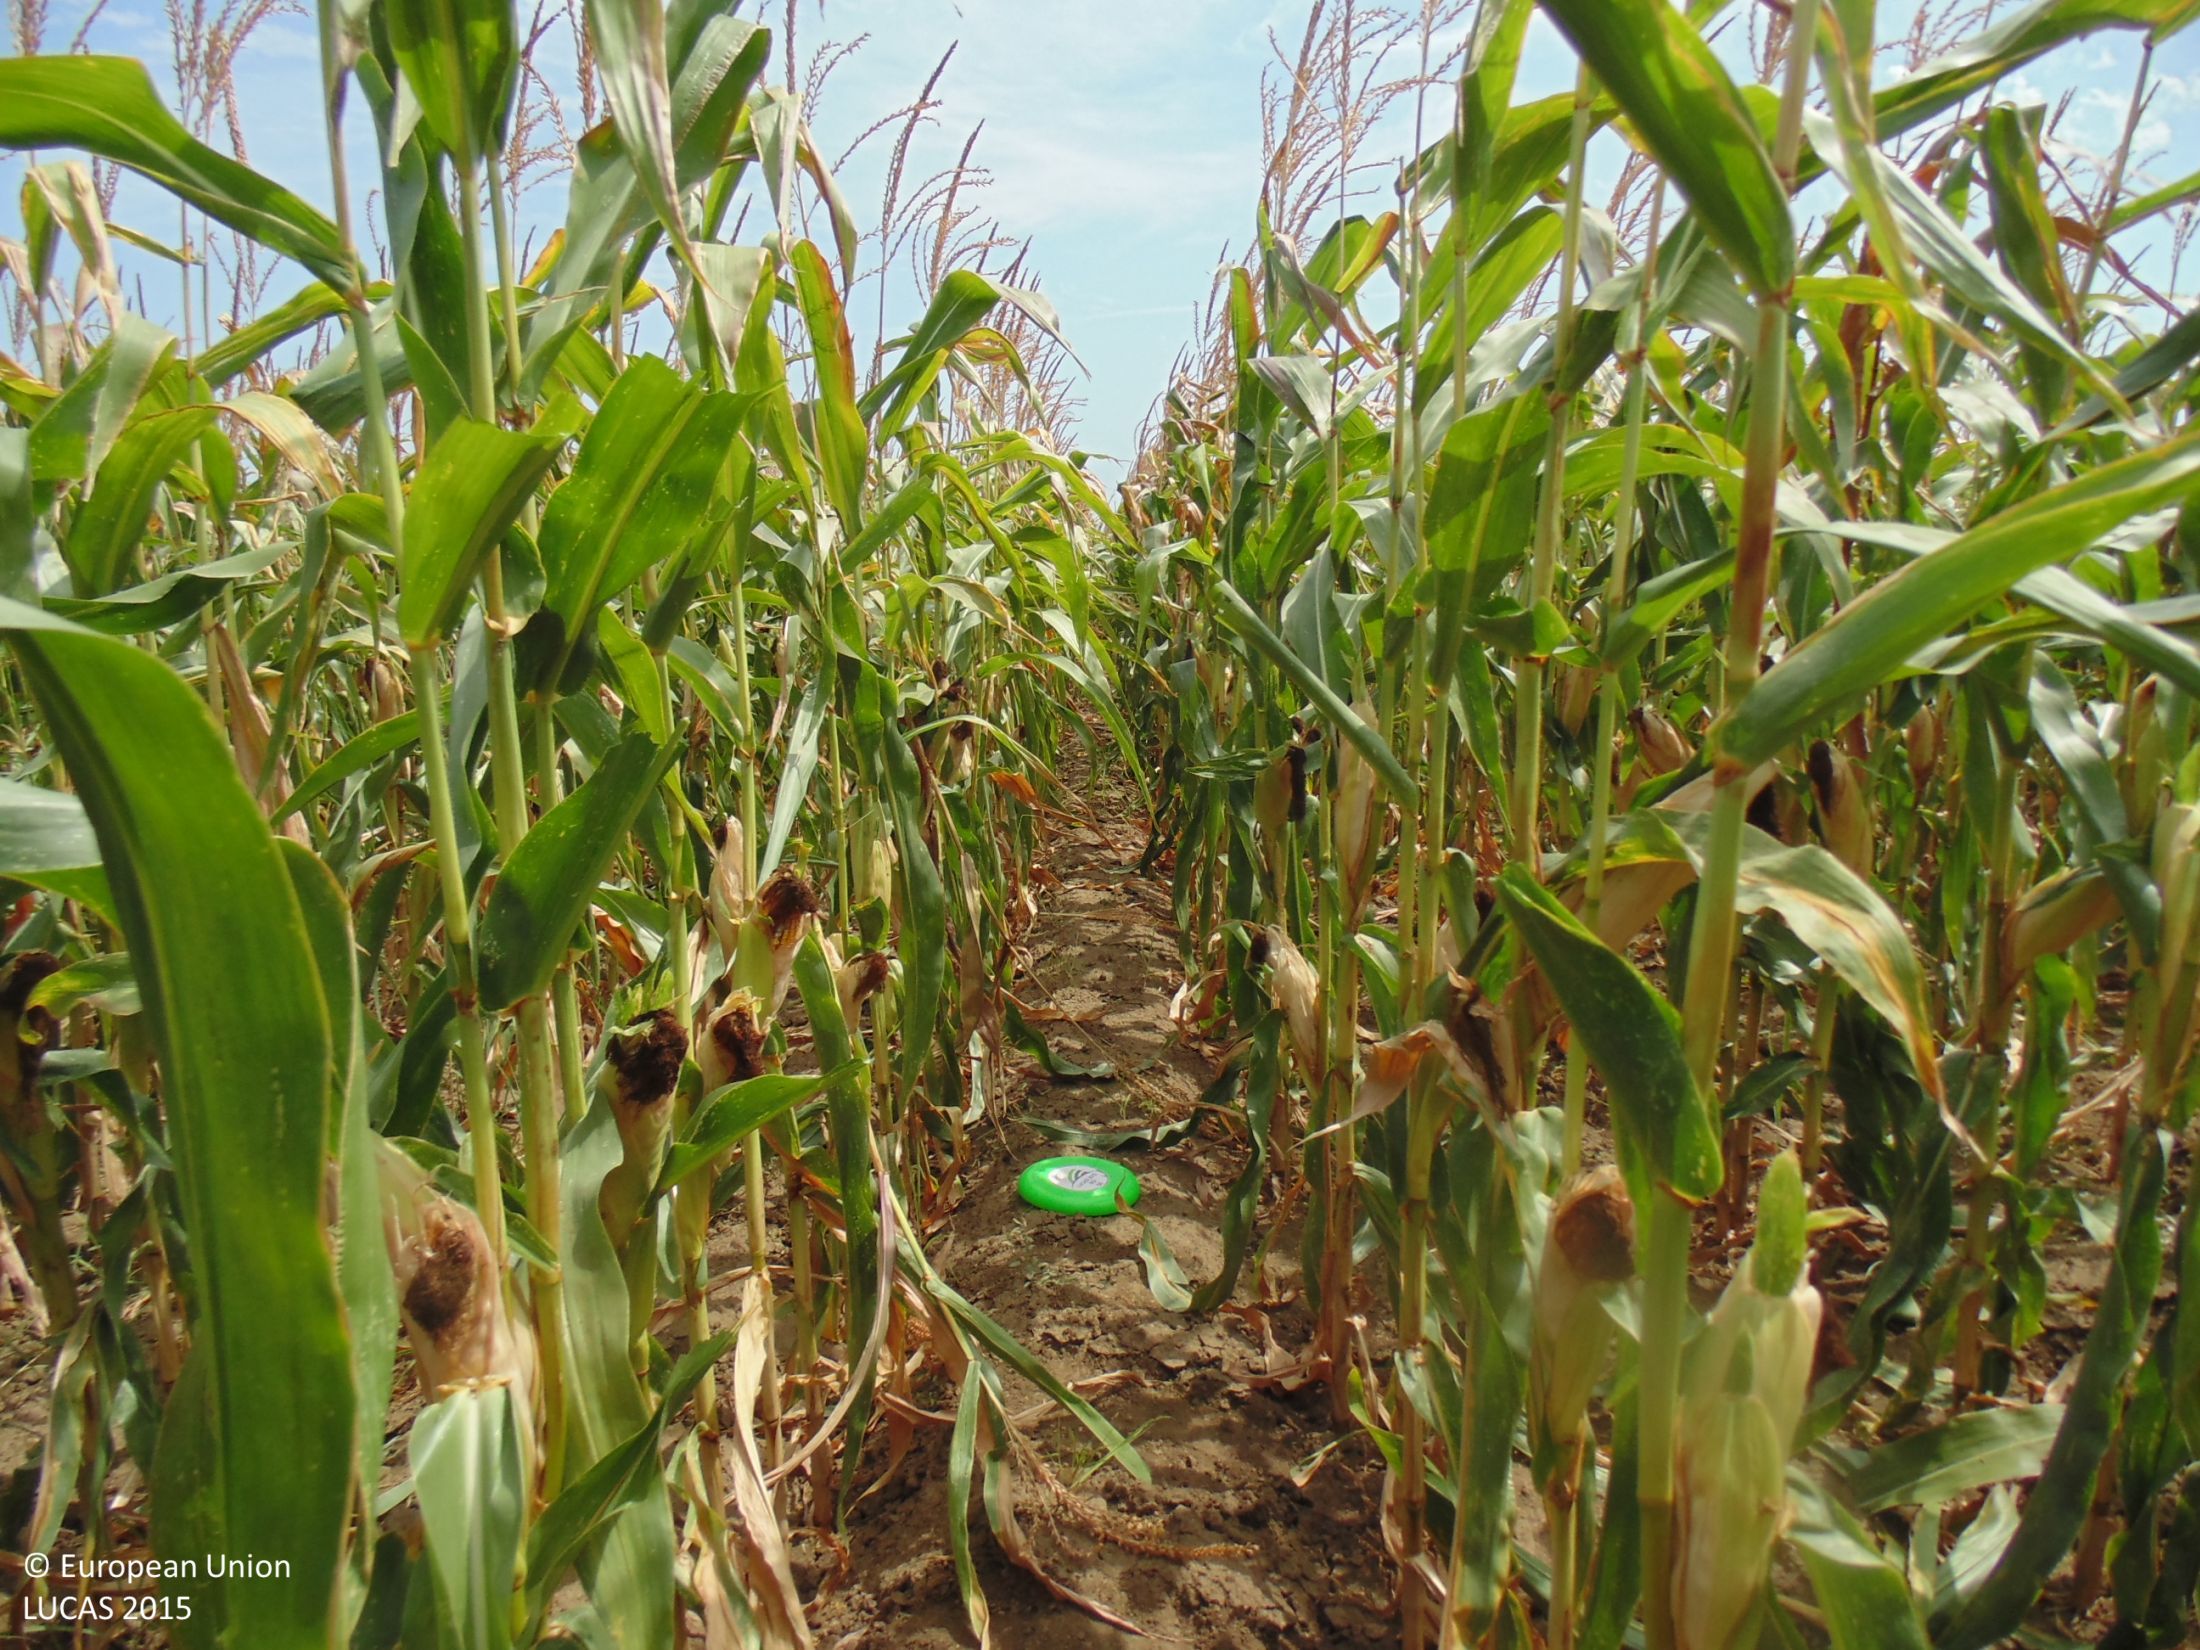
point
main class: Cropland
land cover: Maize
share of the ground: > 75 %
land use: Agriculture (excluding fallow land and kitchen gardens)
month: August
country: BG
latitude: 43.7133
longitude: 28.5464
